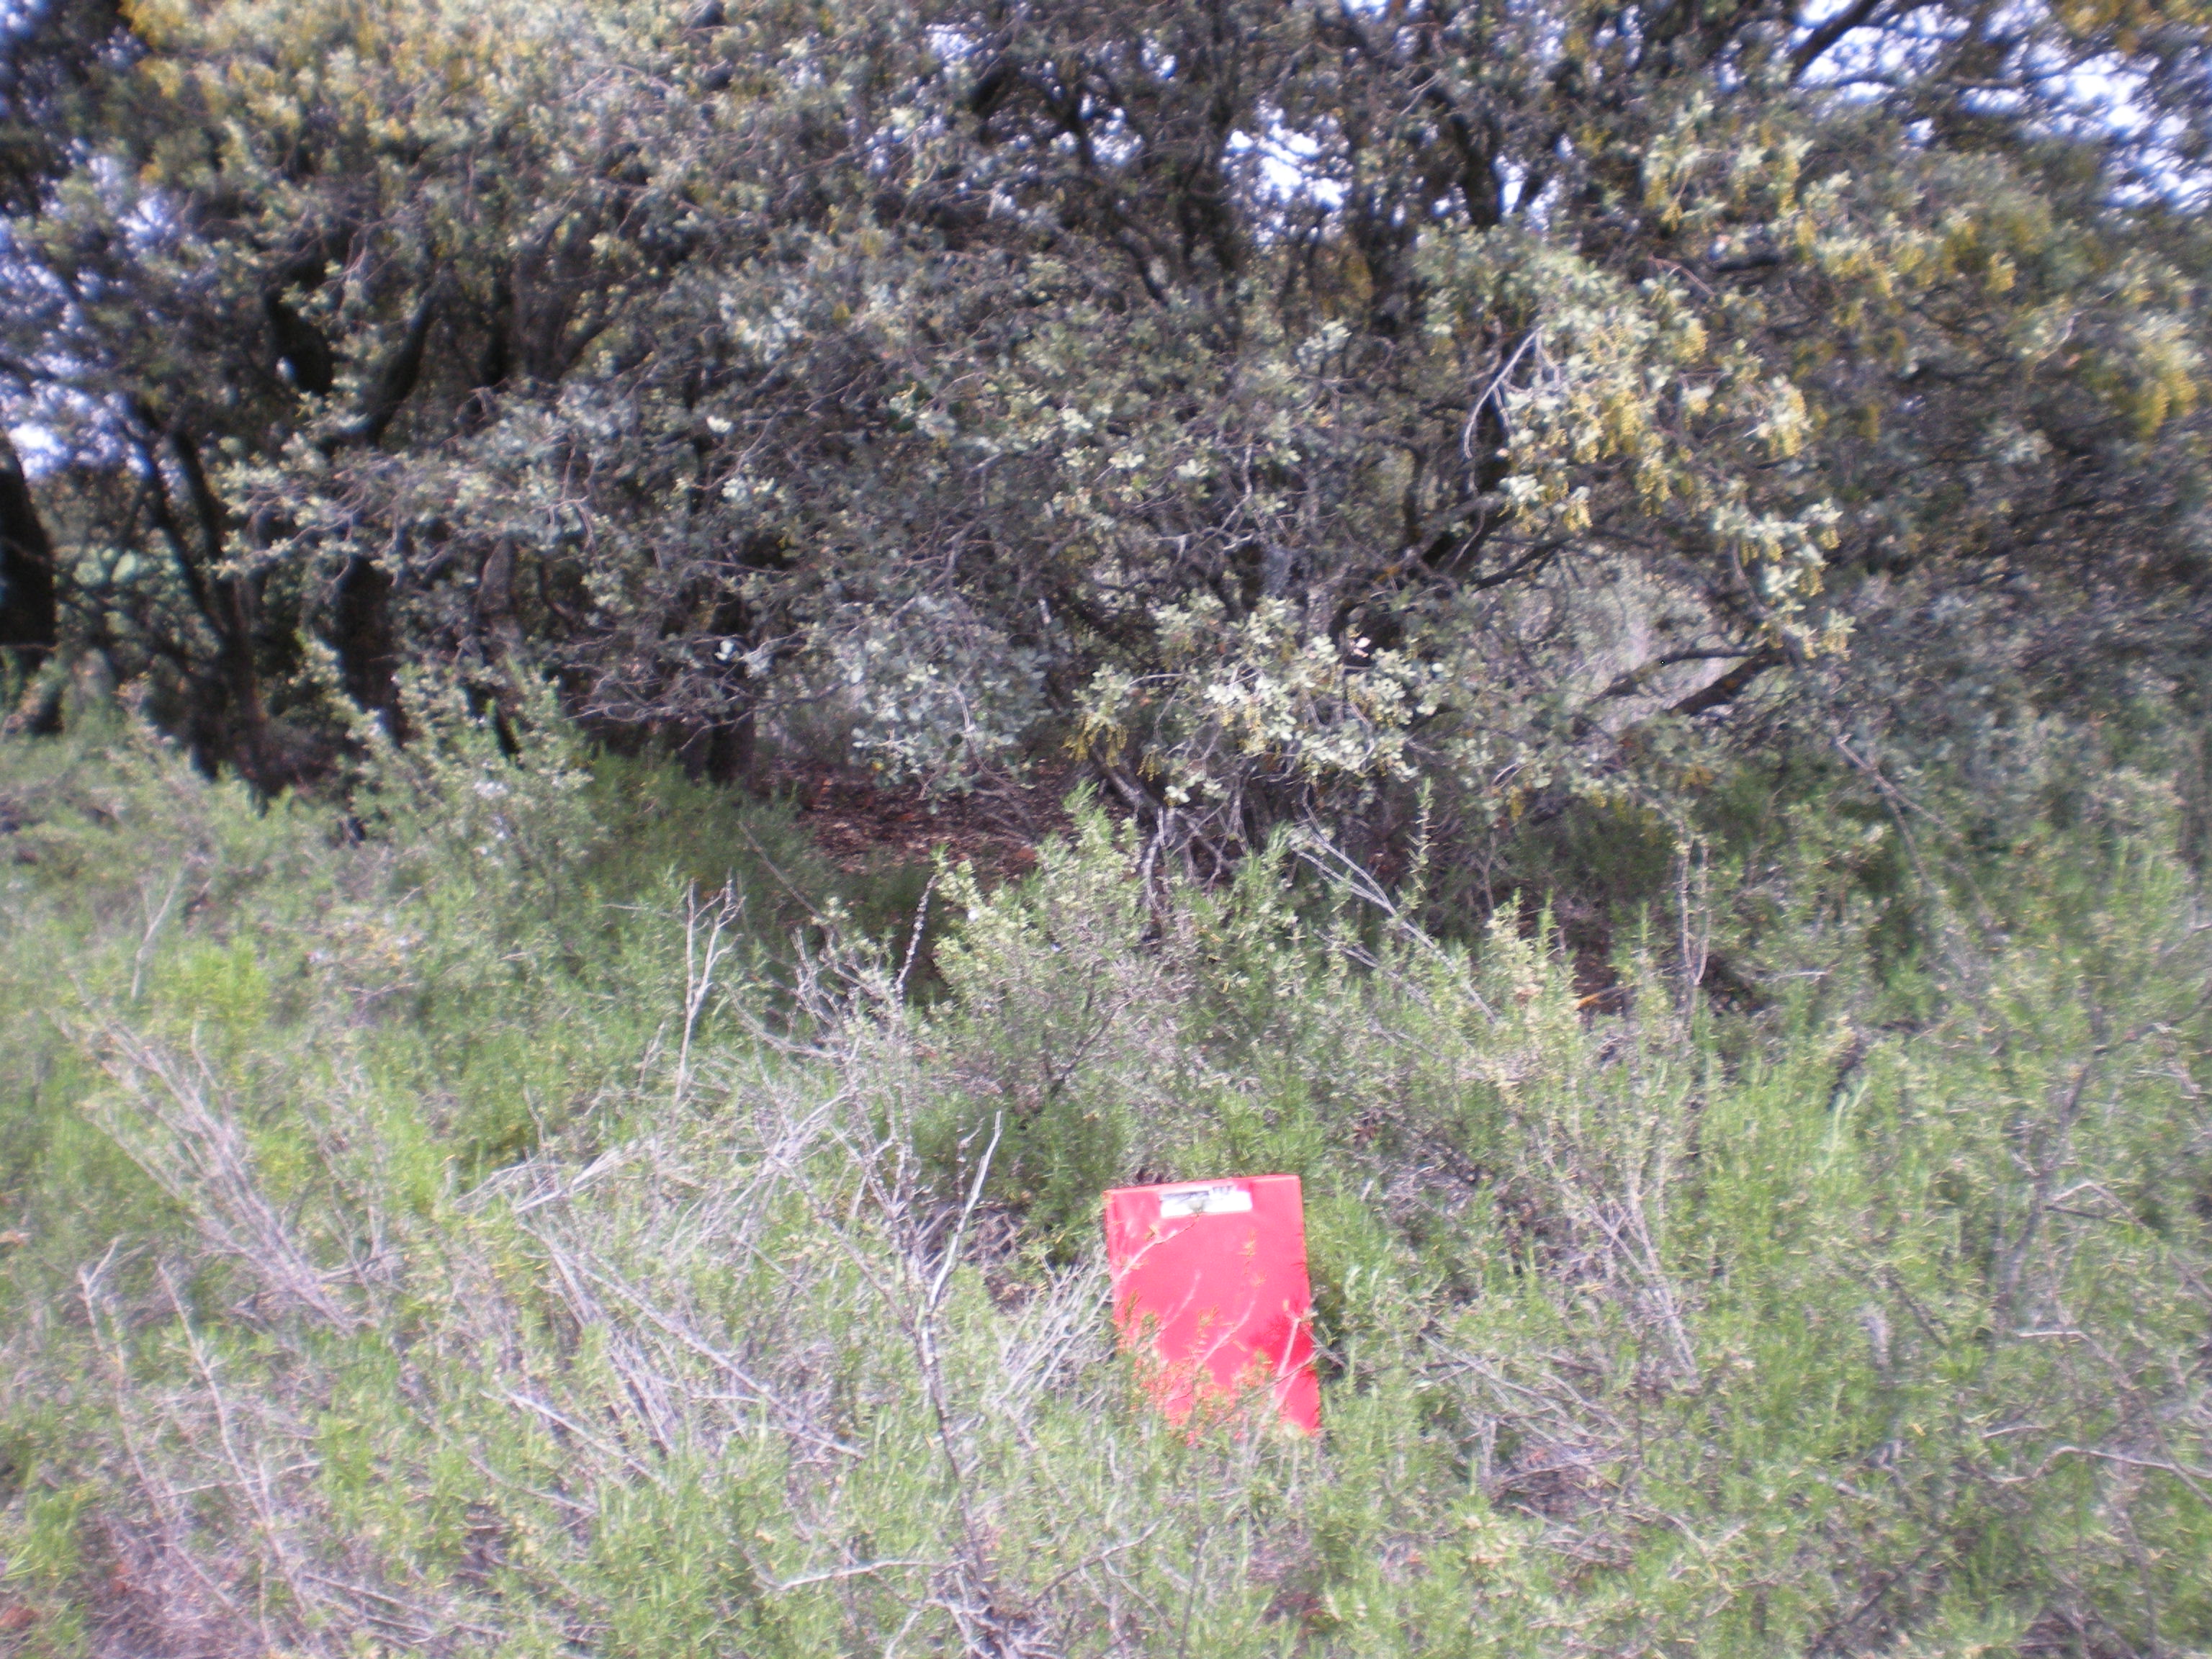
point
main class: Woodland
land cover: Broadleaved woodland
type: broadleaved evergreen forest
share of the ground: 50 - 75 %
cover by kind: broadleaved forest trees 30 %, shrubs 30 %, herbaceous plants 20 %, unconsolidated bare surface 20 %
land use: Other primary production
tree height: < 5 m
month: May
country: ES
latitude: 38.9065
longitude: -2.9818
